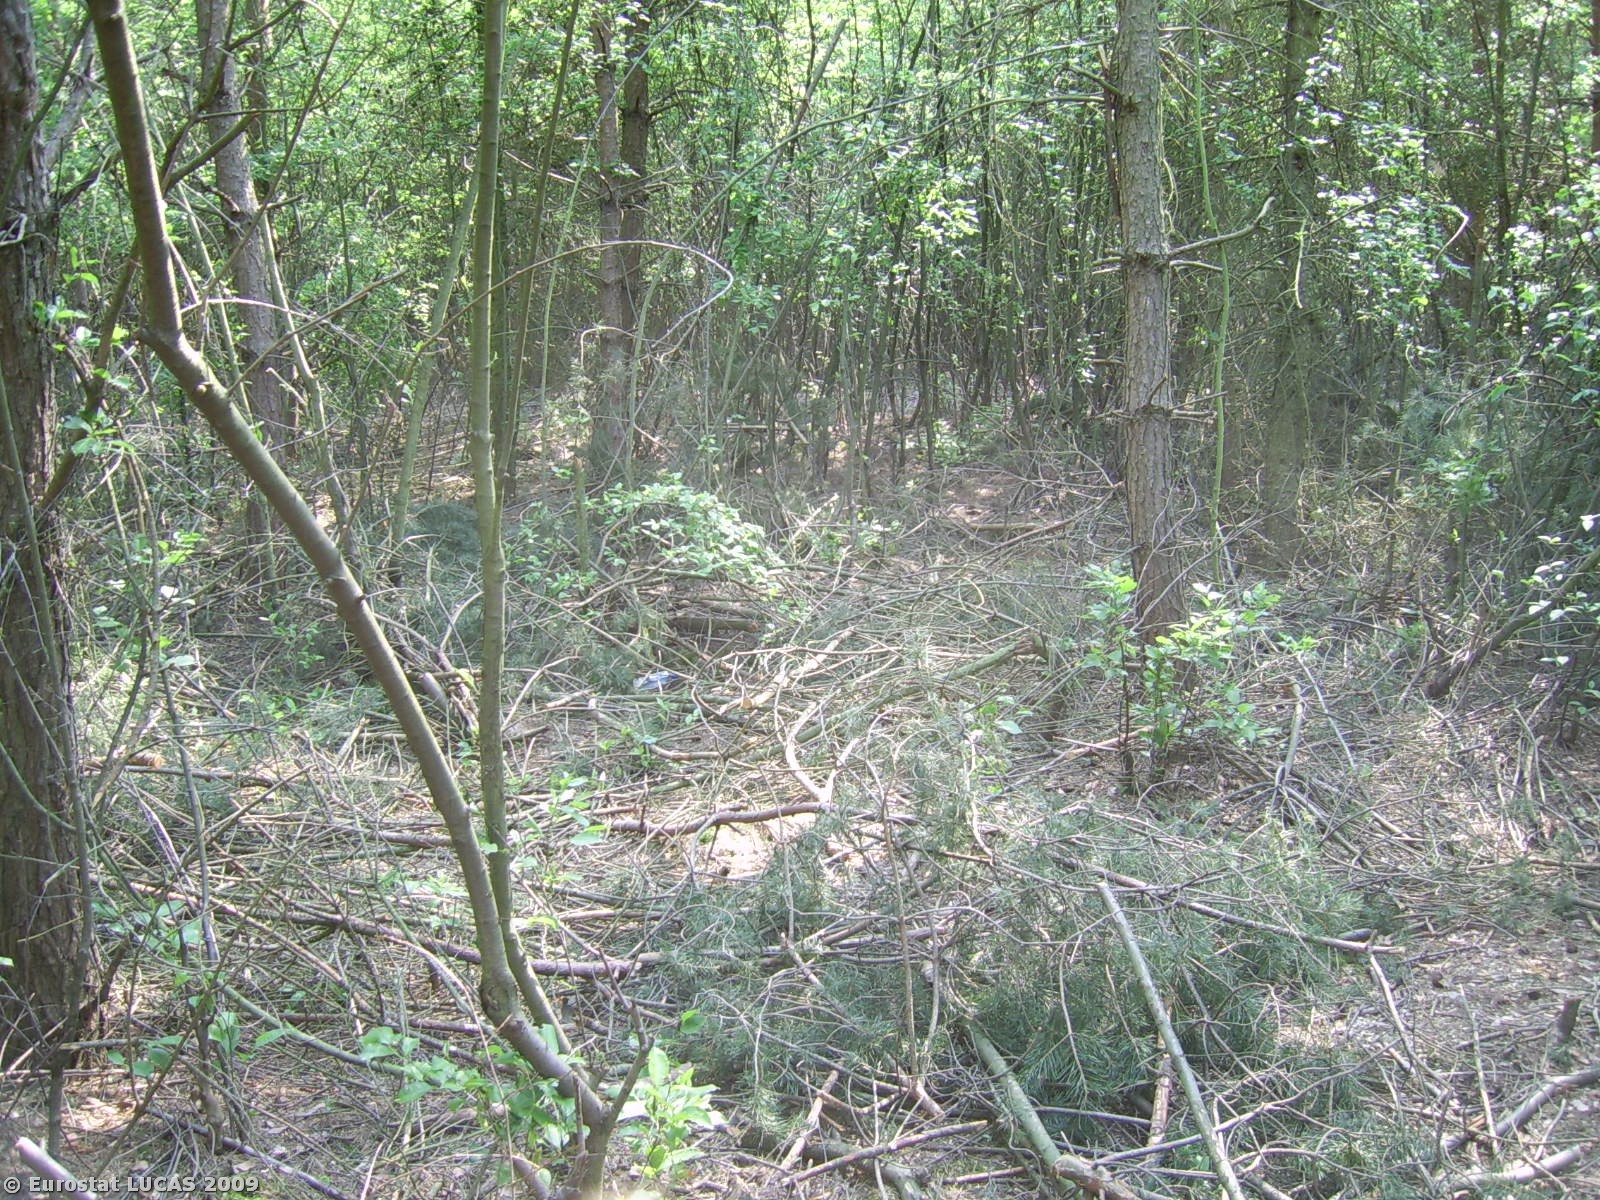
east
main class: Woodland
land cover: Mixed woodland
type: hemiboreal forest and nemoral coniferous forest and mixed broadleaved-coniferous forest
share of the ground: > 75 %
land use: Forestry
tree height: > 5 m
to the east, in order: Mixed woodland; Paved roads, cycling and walking lanes; Broadleaved woodland
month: April
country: PL
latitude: 52.0500
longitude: 16.9068
